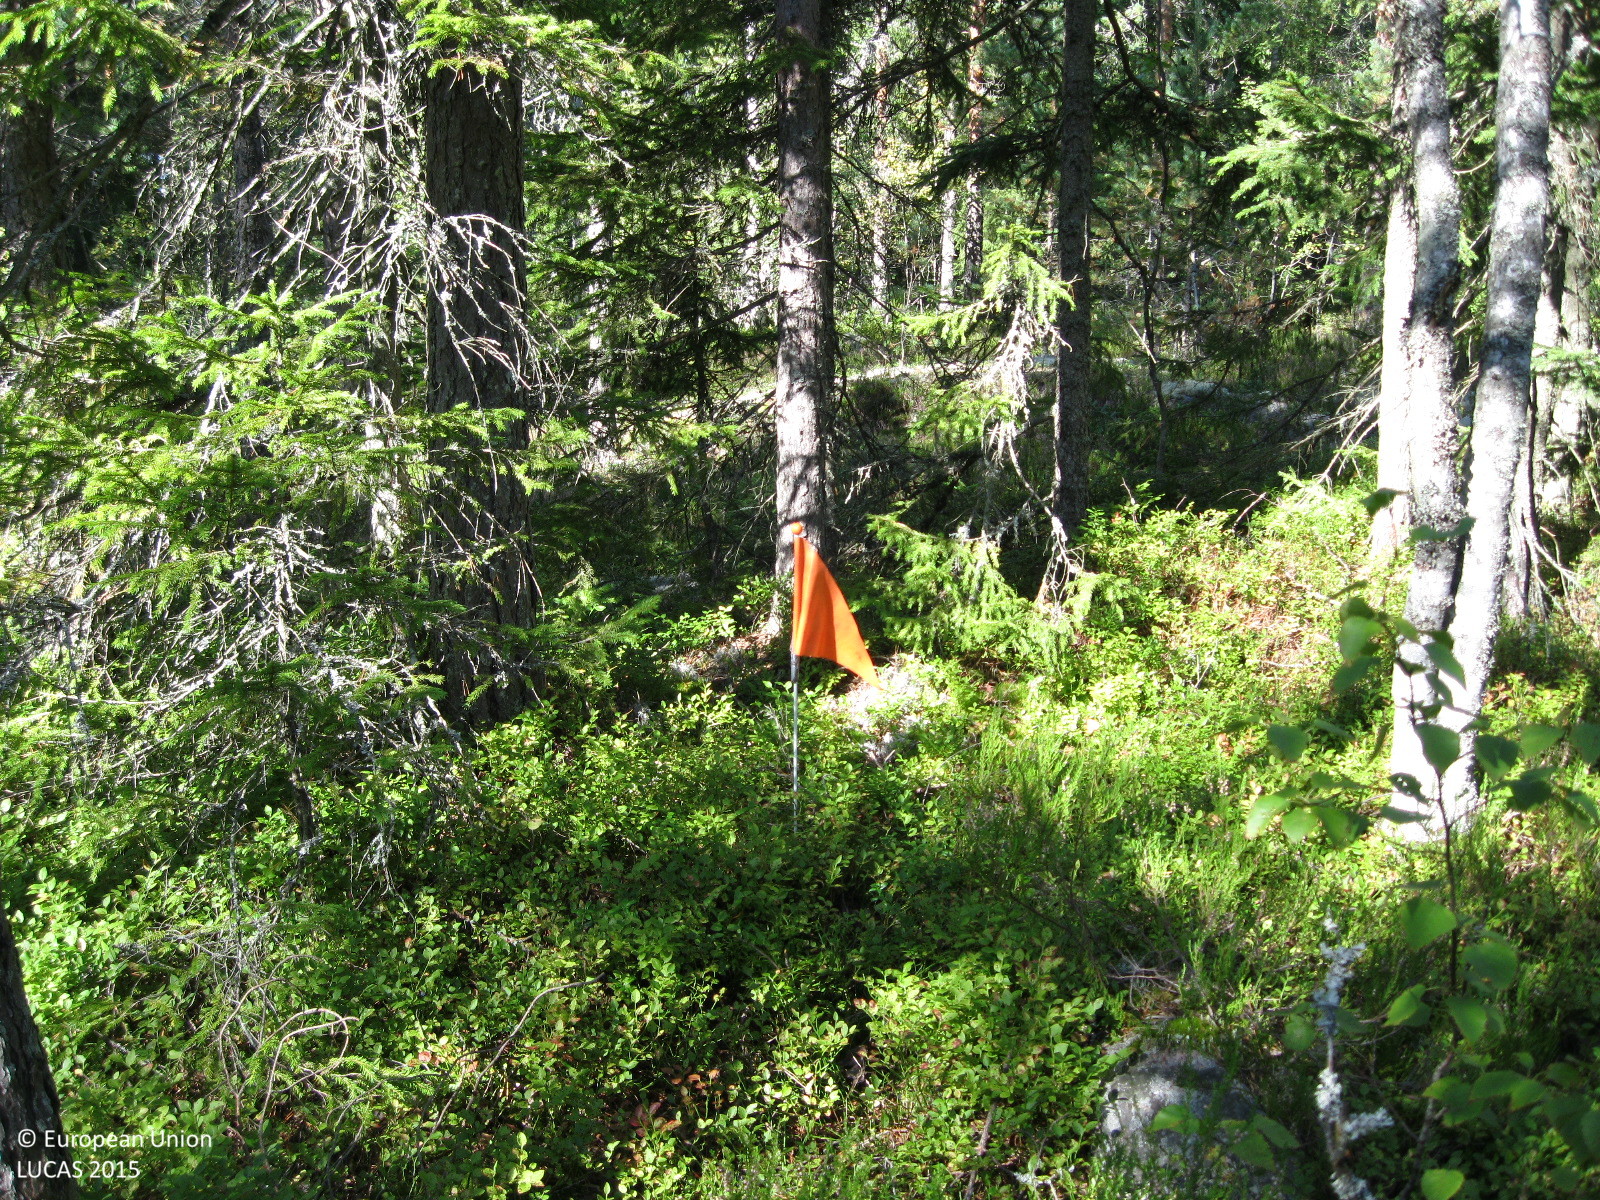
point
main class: Woodland
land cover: Pine dominated coniferous woodland
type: boreal forest
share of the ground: 50 - 75 %
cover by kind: coniferous forest trees 65 %, shrubs 15 %, herbaceous plants 15 %, broadleaved forest trees 5 %
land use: Forestry
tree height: > 5 m
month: September
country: FI
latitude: 60.6320
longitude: 24.9026
